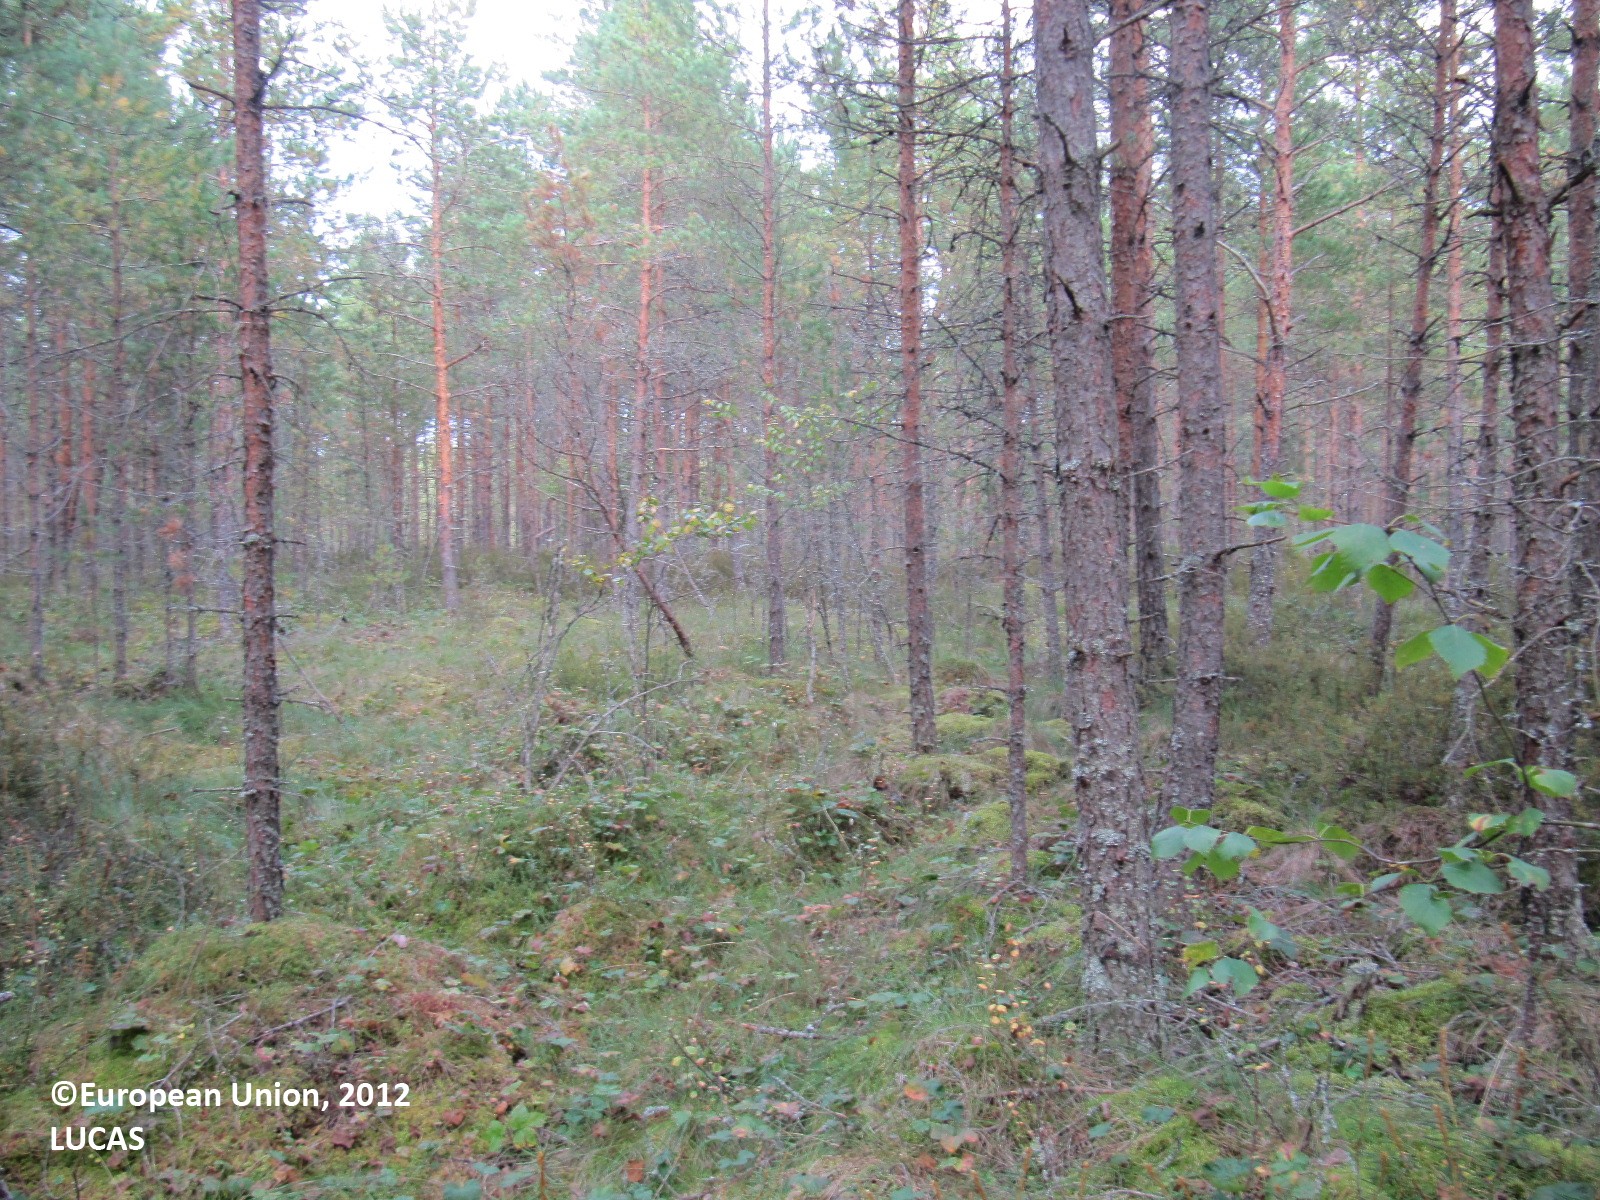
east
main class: Woodland
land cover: Pine dominated coniferous woodland
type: boreal forest
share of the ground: > 75 %
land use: Forestry
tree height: > 5 m
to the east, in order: Pine dominated coniferous woodland
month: August
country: FI
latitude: 61.0617
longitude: 22.9495
